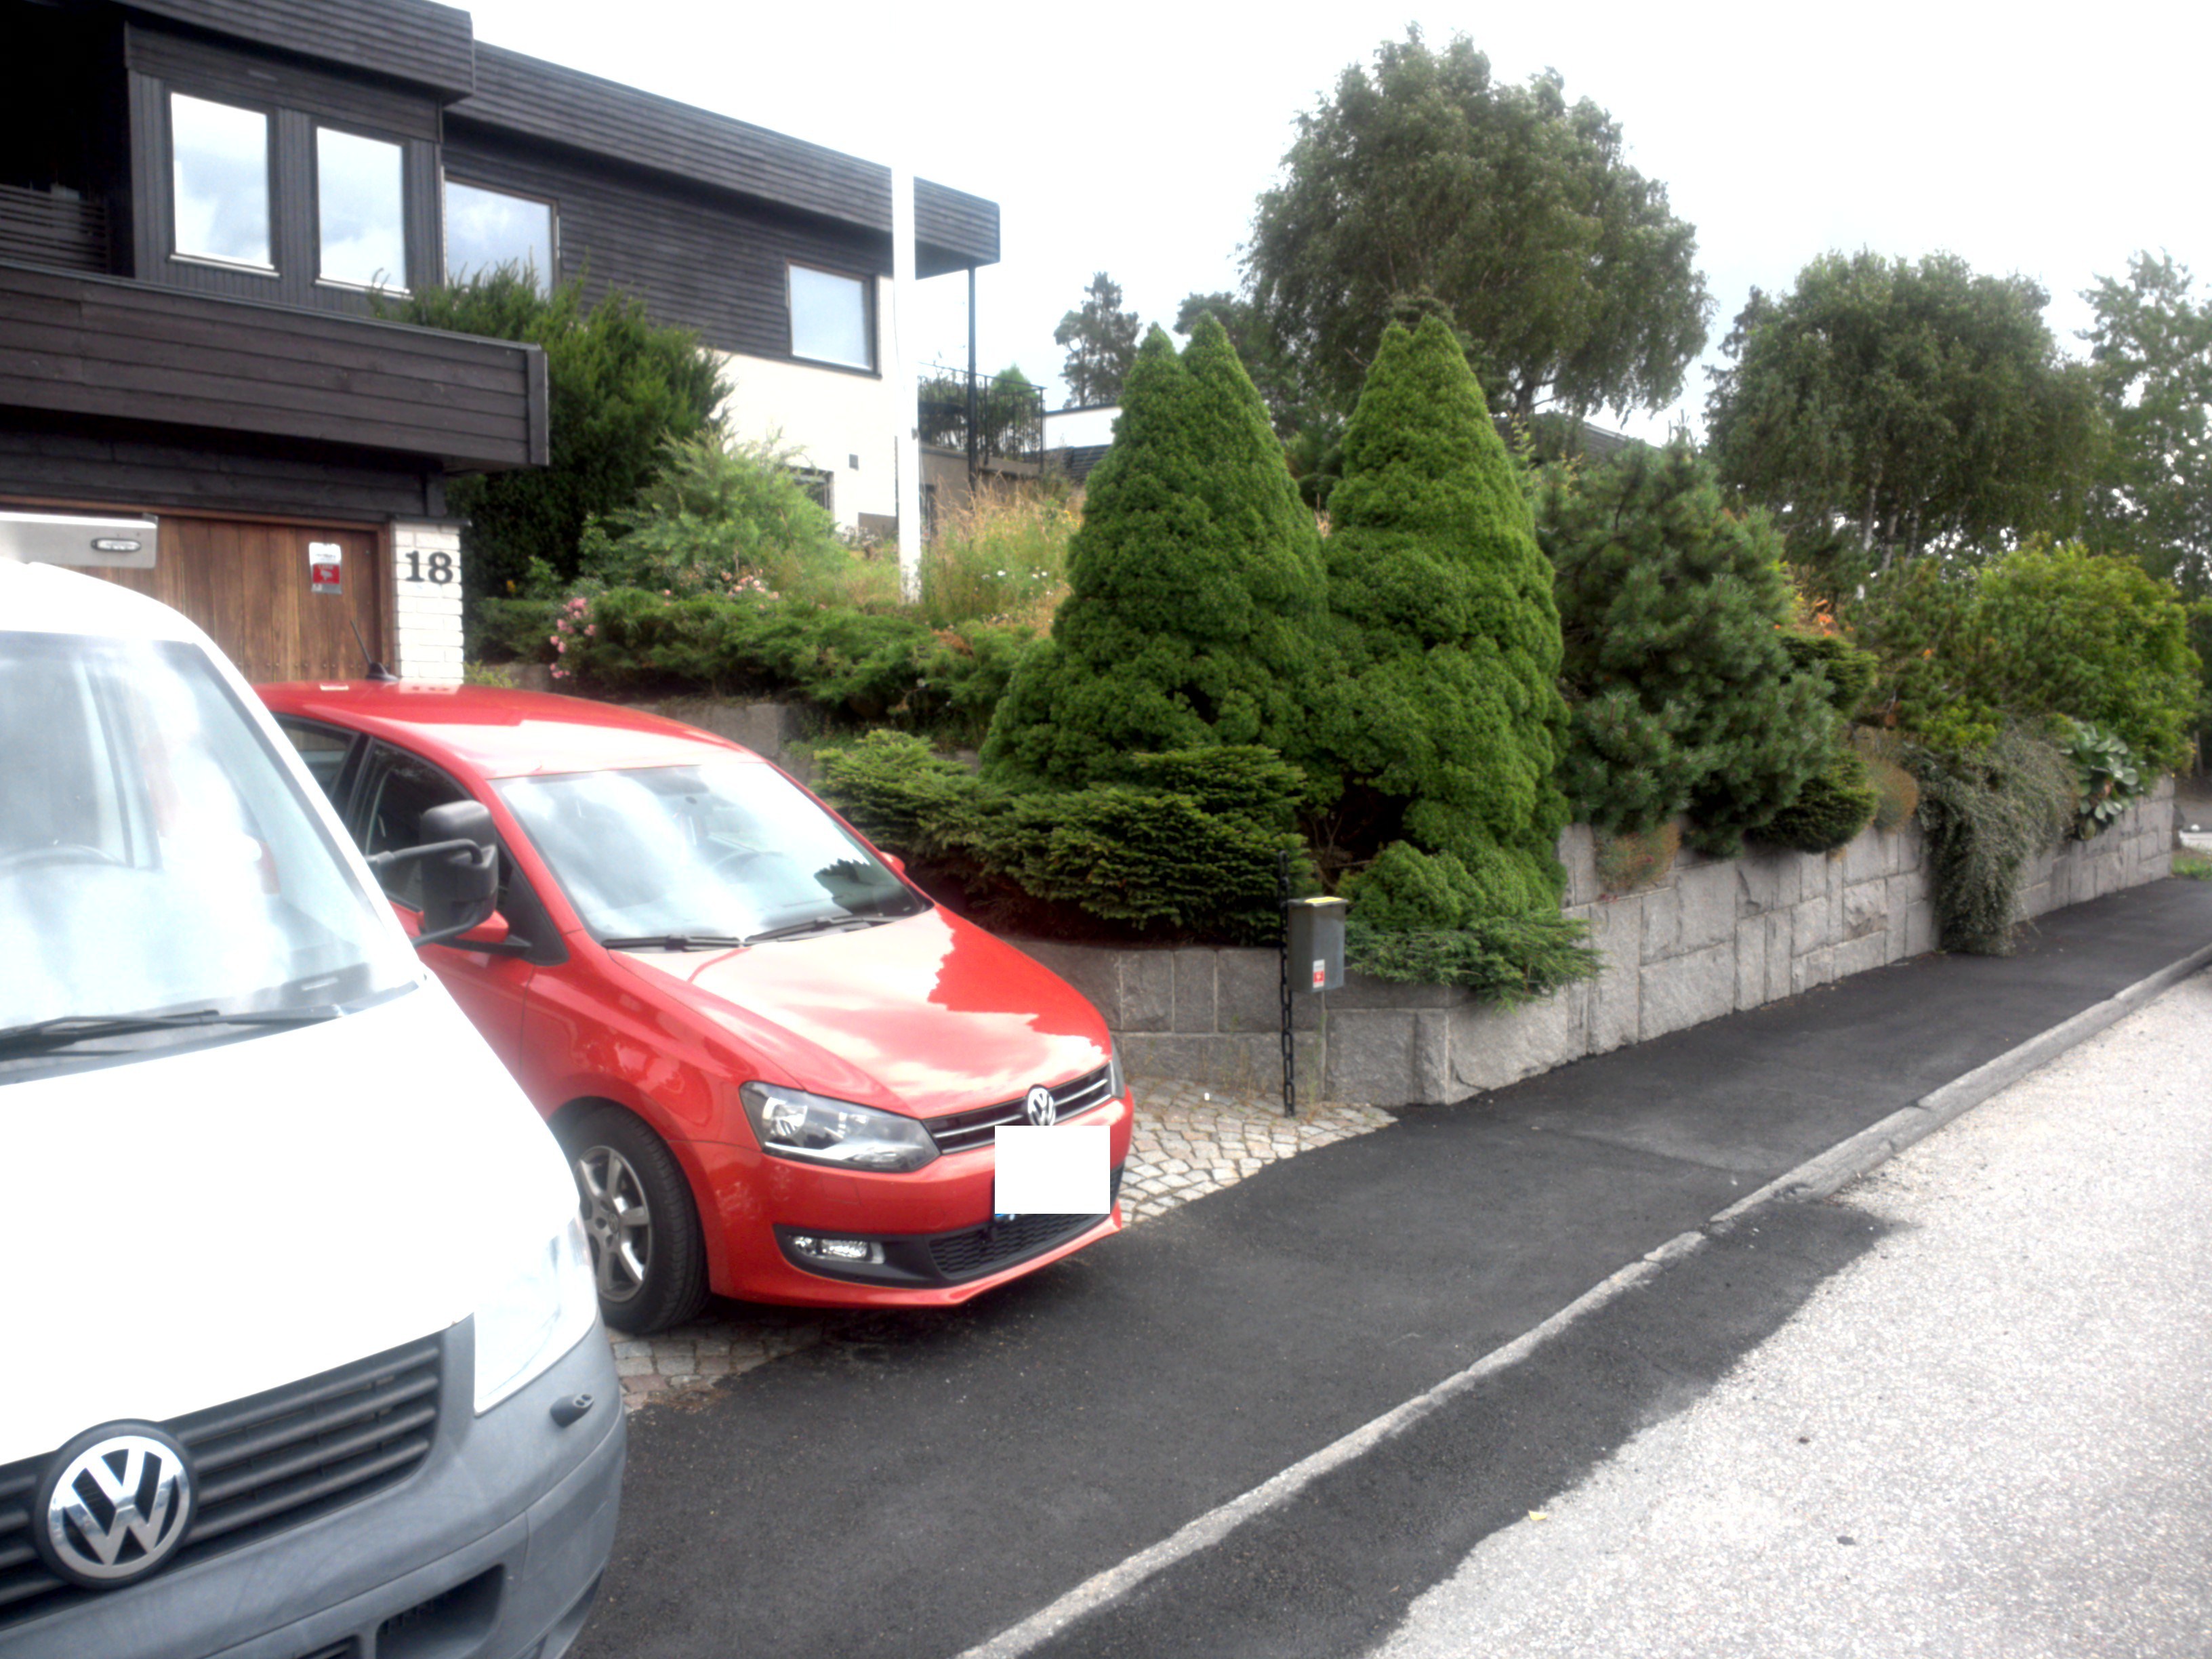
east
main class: Shrubland
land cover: Shrubland with sparse tree cover
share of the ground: 50 - 75 %
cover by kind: shrubs 75 %, herbaceous plants 20 %, coniferous forest trees 5 %
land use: Residential
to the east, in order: Shrubland with sparse tree cover; Artificial constructions in urban areas; Pine dominated coniferous woodland; Artificial constructions in urban areas
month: July
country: SE
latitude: 59.2324
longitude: 18.2547
